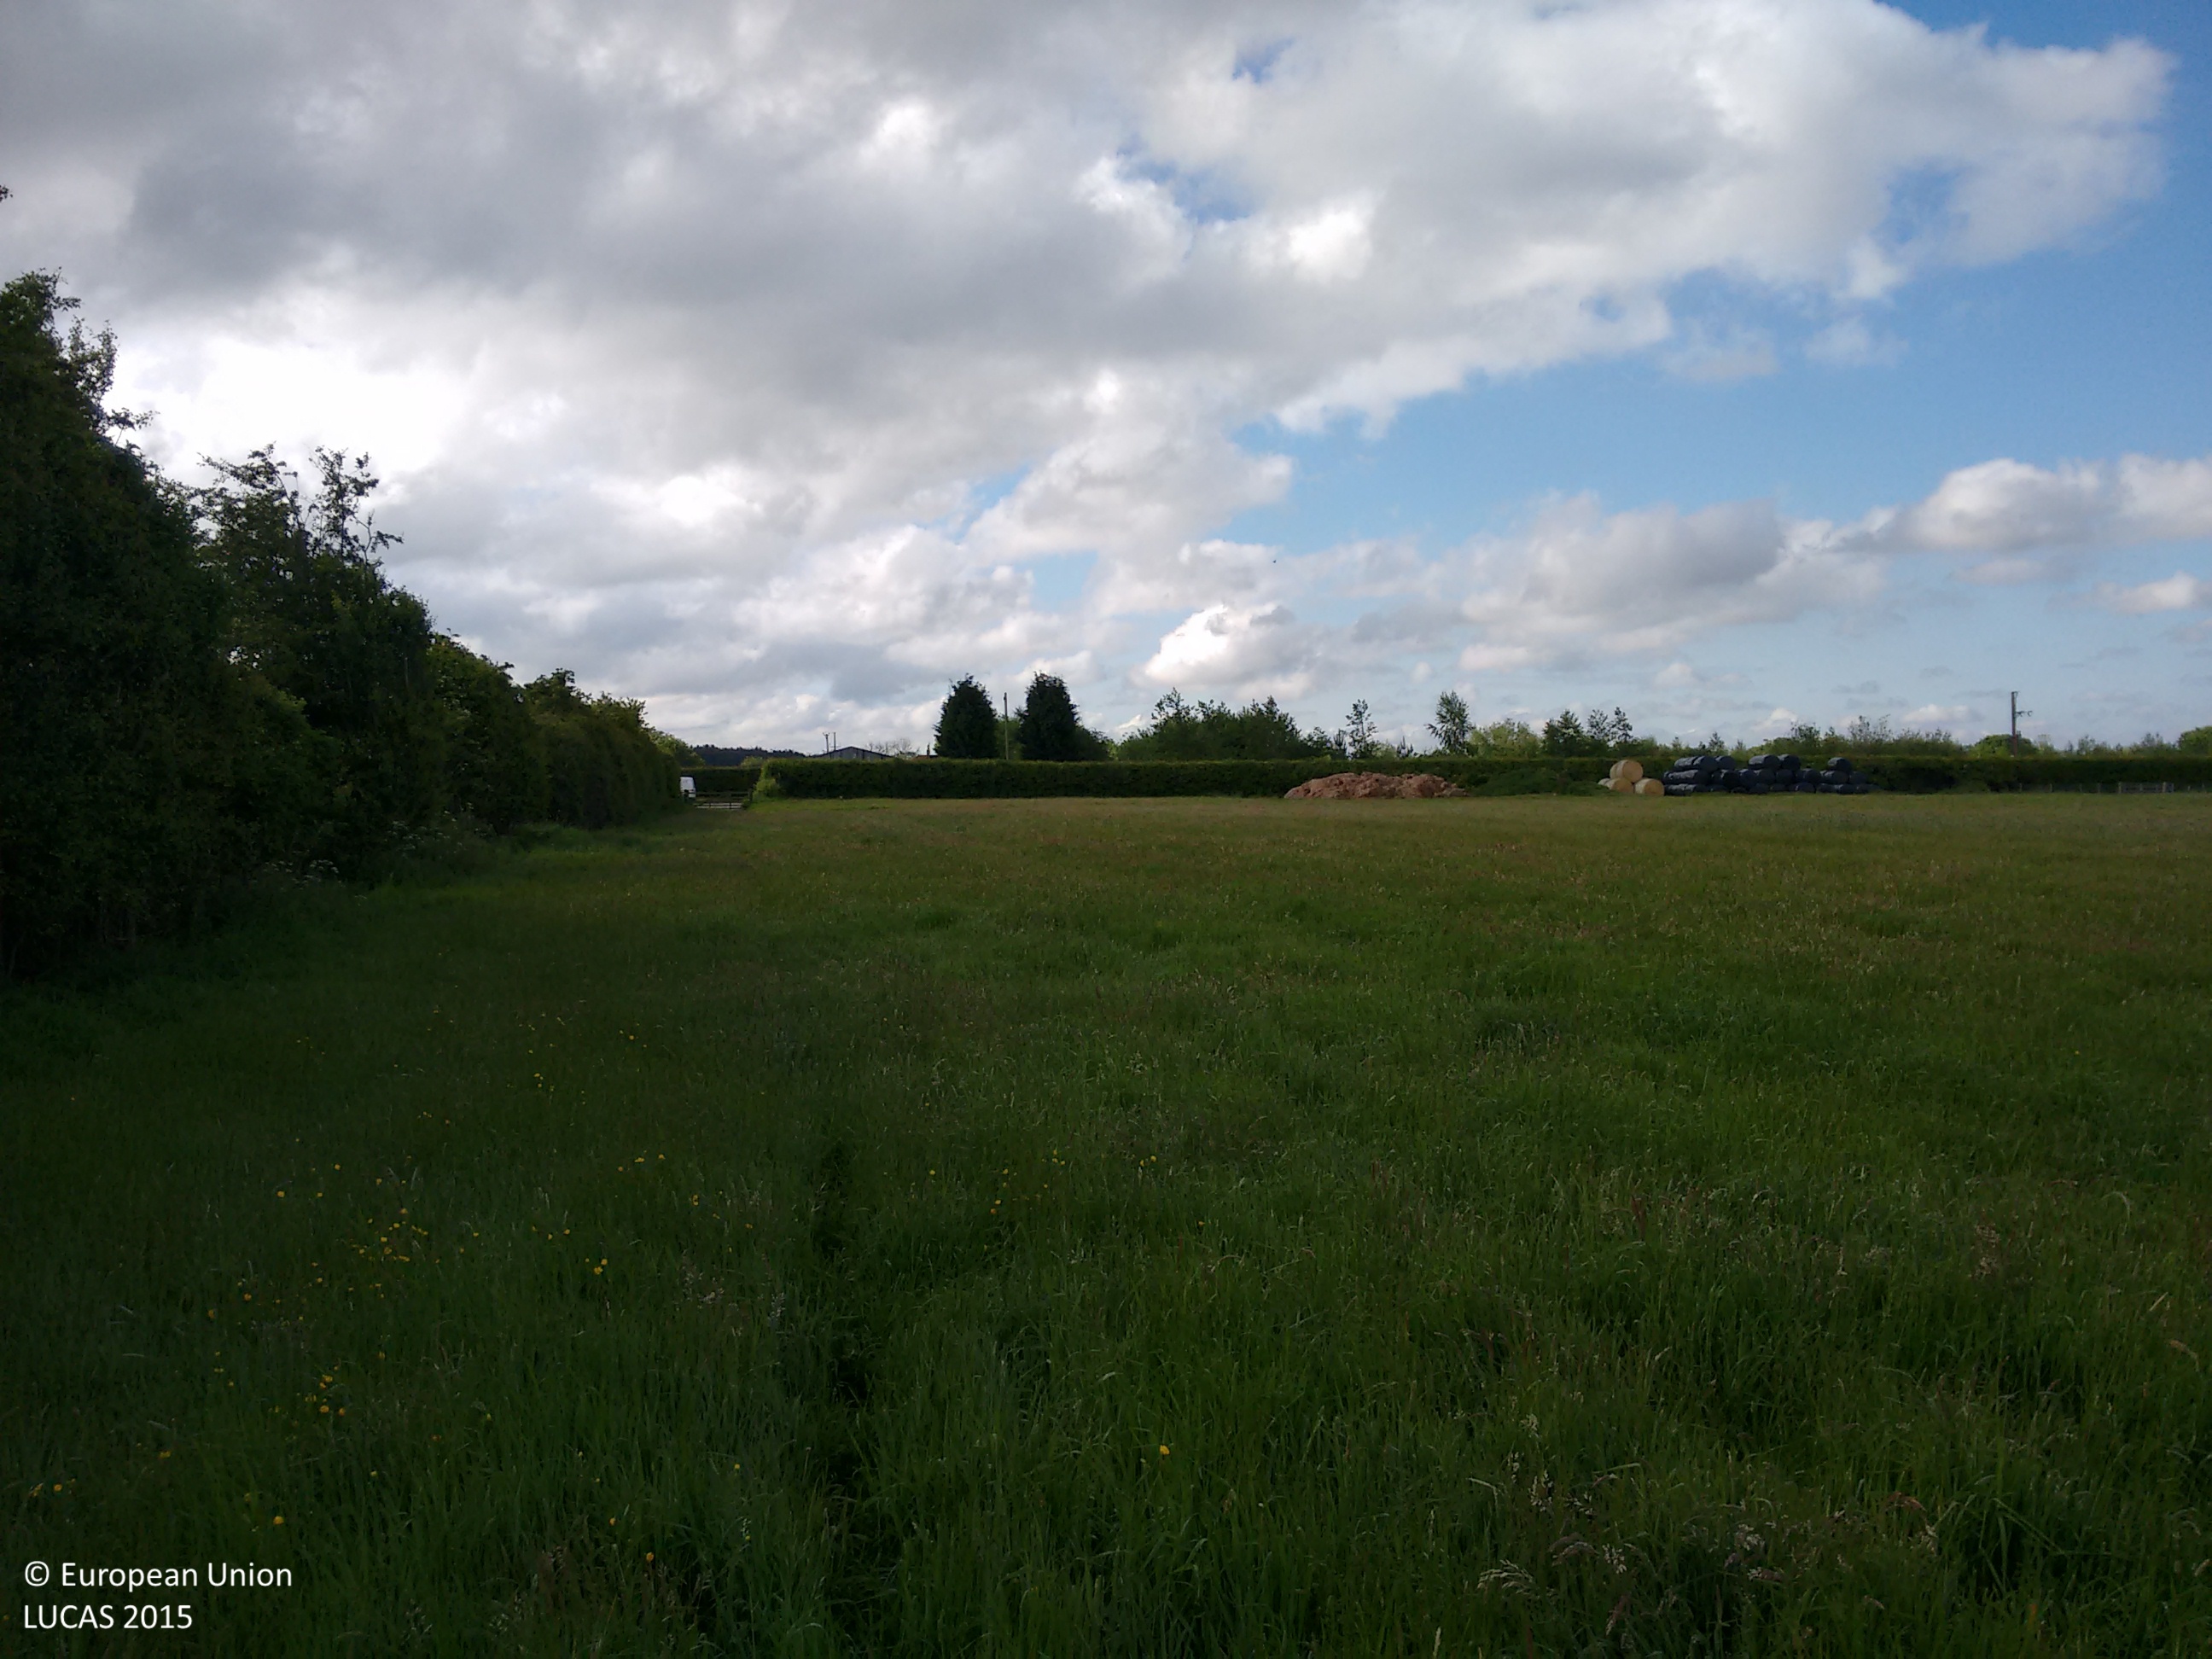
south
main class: Grassland
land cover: Grassland without tree/shrub cover
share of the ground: > 75 %
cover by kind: herbaceous plants 100 %
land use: Agriculture (excluding fallow land and kitchen gardens)
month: June
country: GB
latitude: 54.0802
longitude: -1.1878
